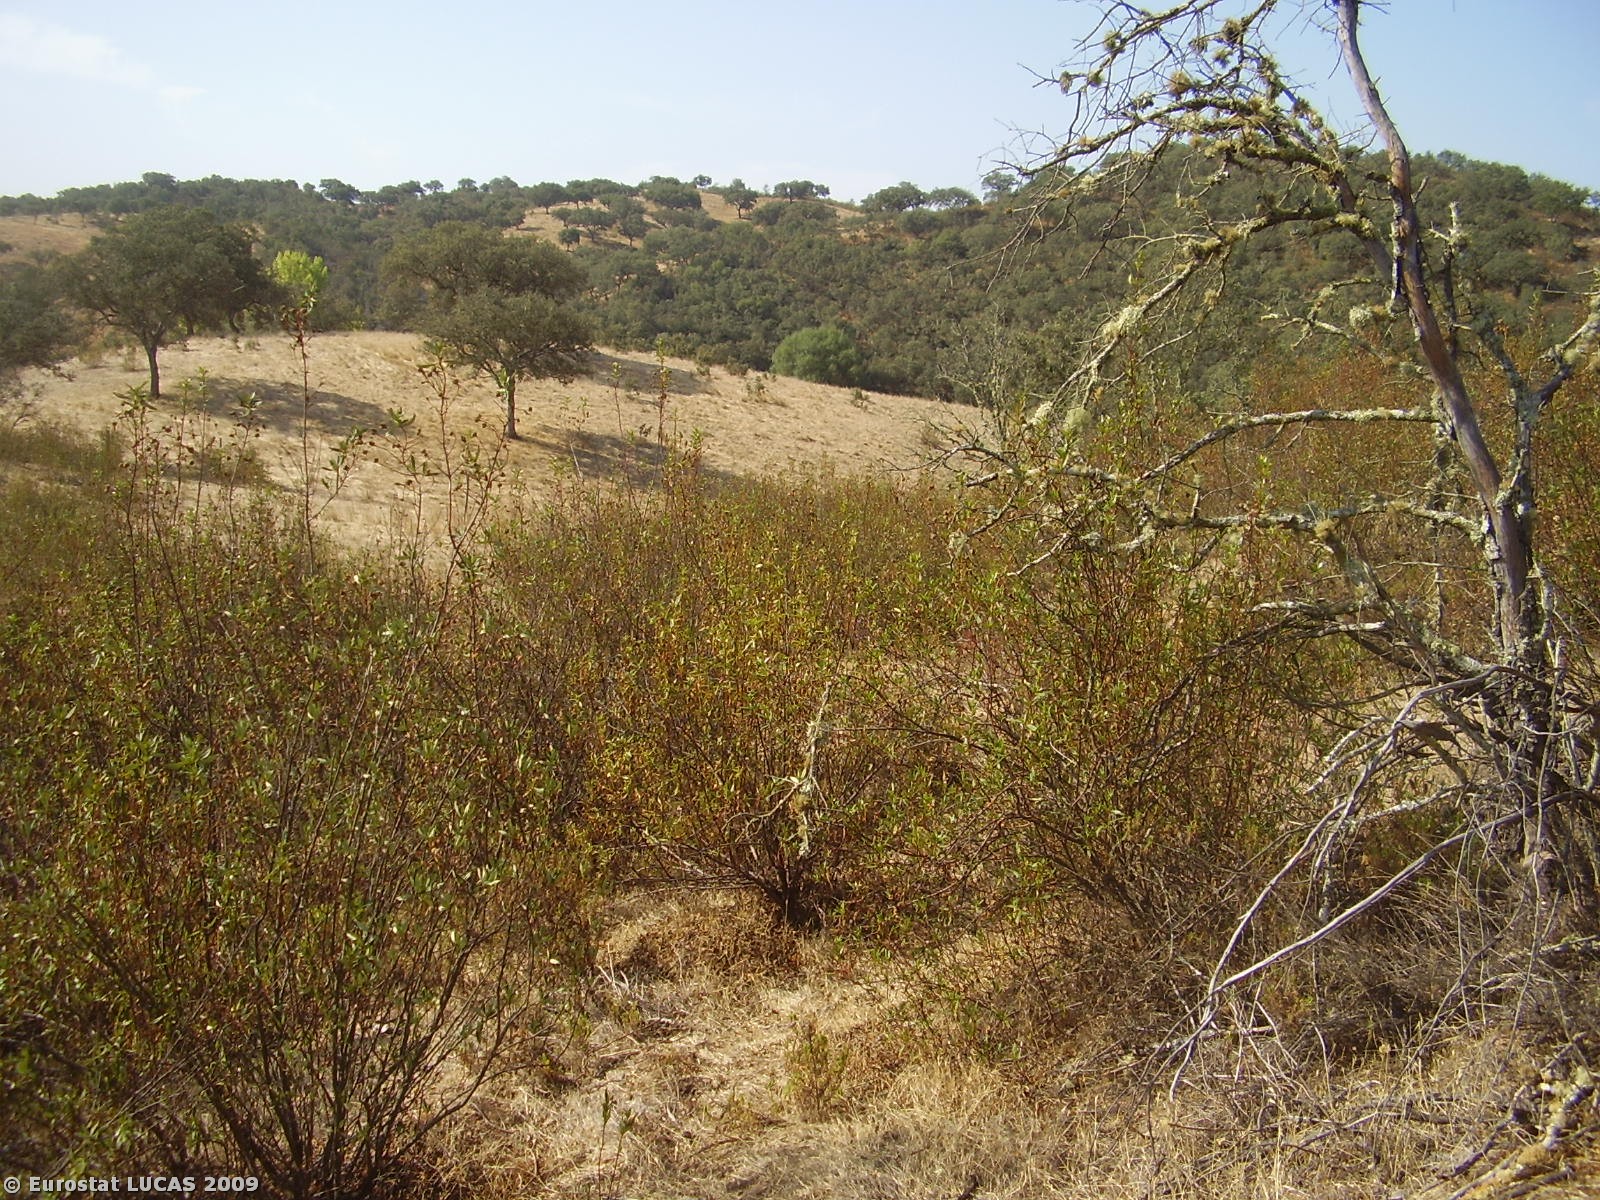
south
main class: Shrubland
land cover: Shrubland with sparse tree cover
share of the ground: 50 - 75 %
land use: Forestry
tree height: > 5 m
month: August
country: PT
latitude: 37.5598
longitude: -8.2422
